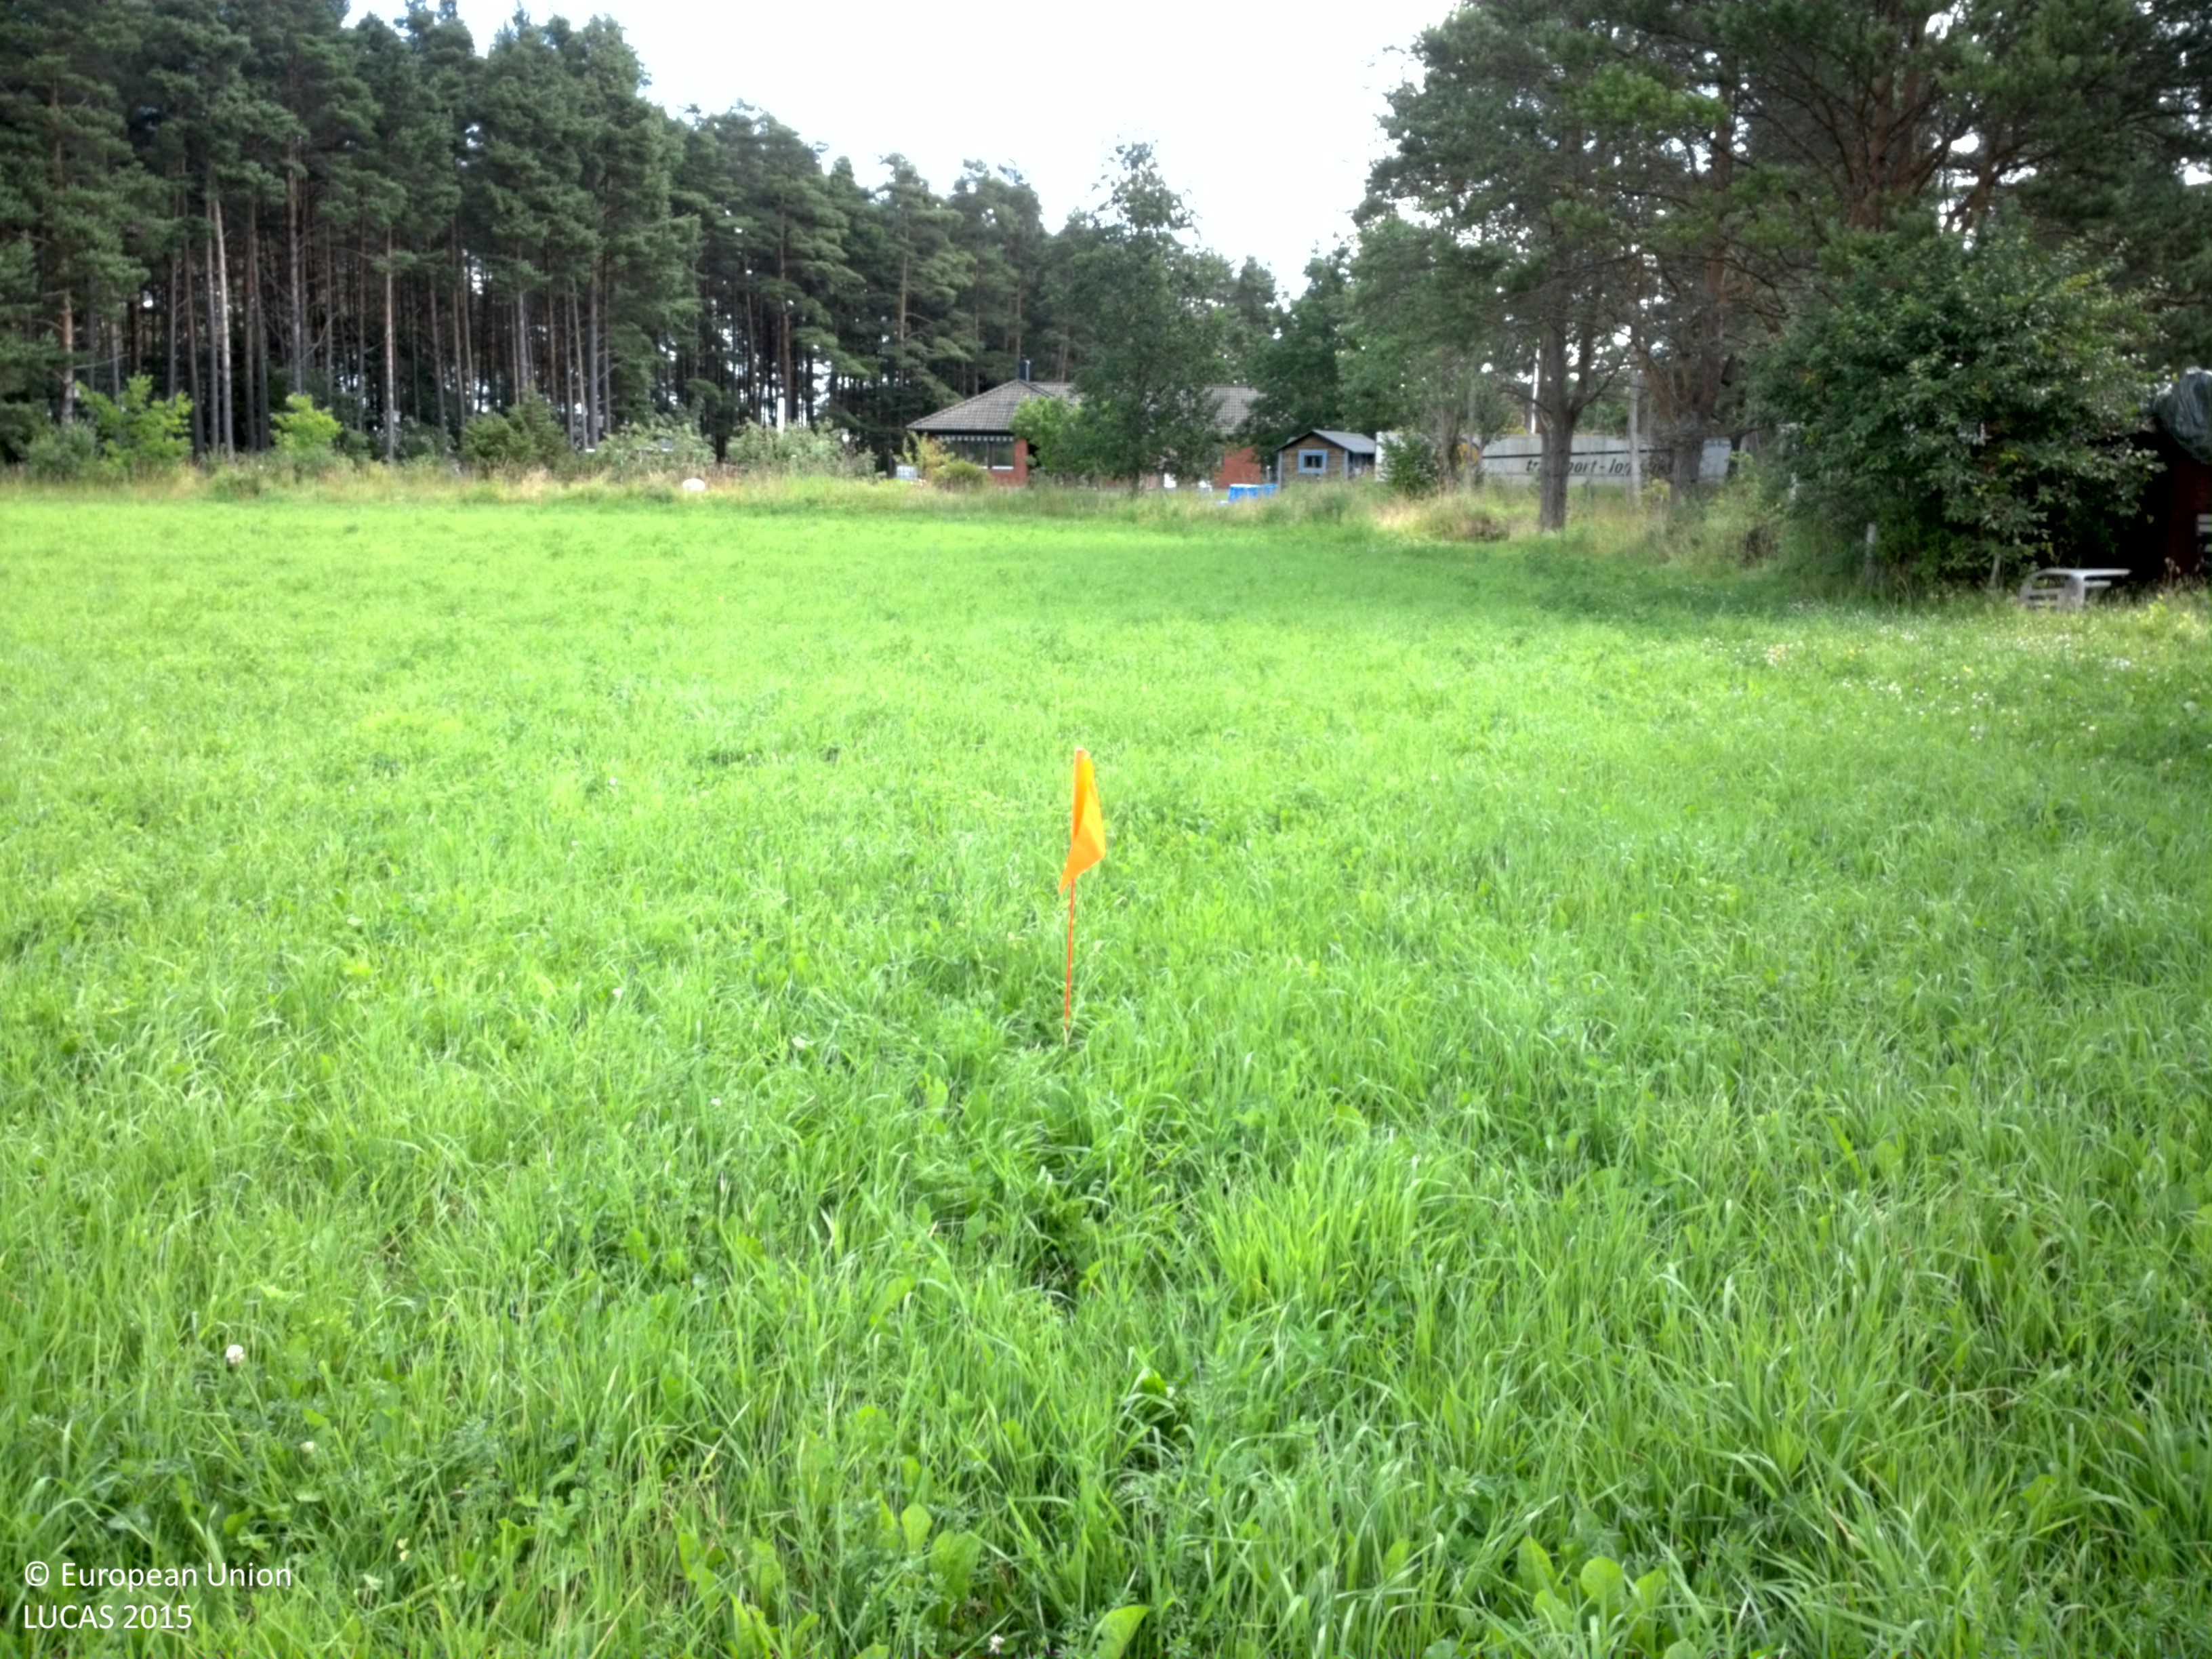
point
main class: Grassland
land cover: Grassland without tree/shrub cover
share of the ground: > 75 %
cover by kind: herbaceous plants 100 %
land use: Agriculture (excluding fallow land and kitchen gardens)
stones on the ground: < 10 %
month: July
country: SE
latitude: 57.5688
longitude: 18.5183
